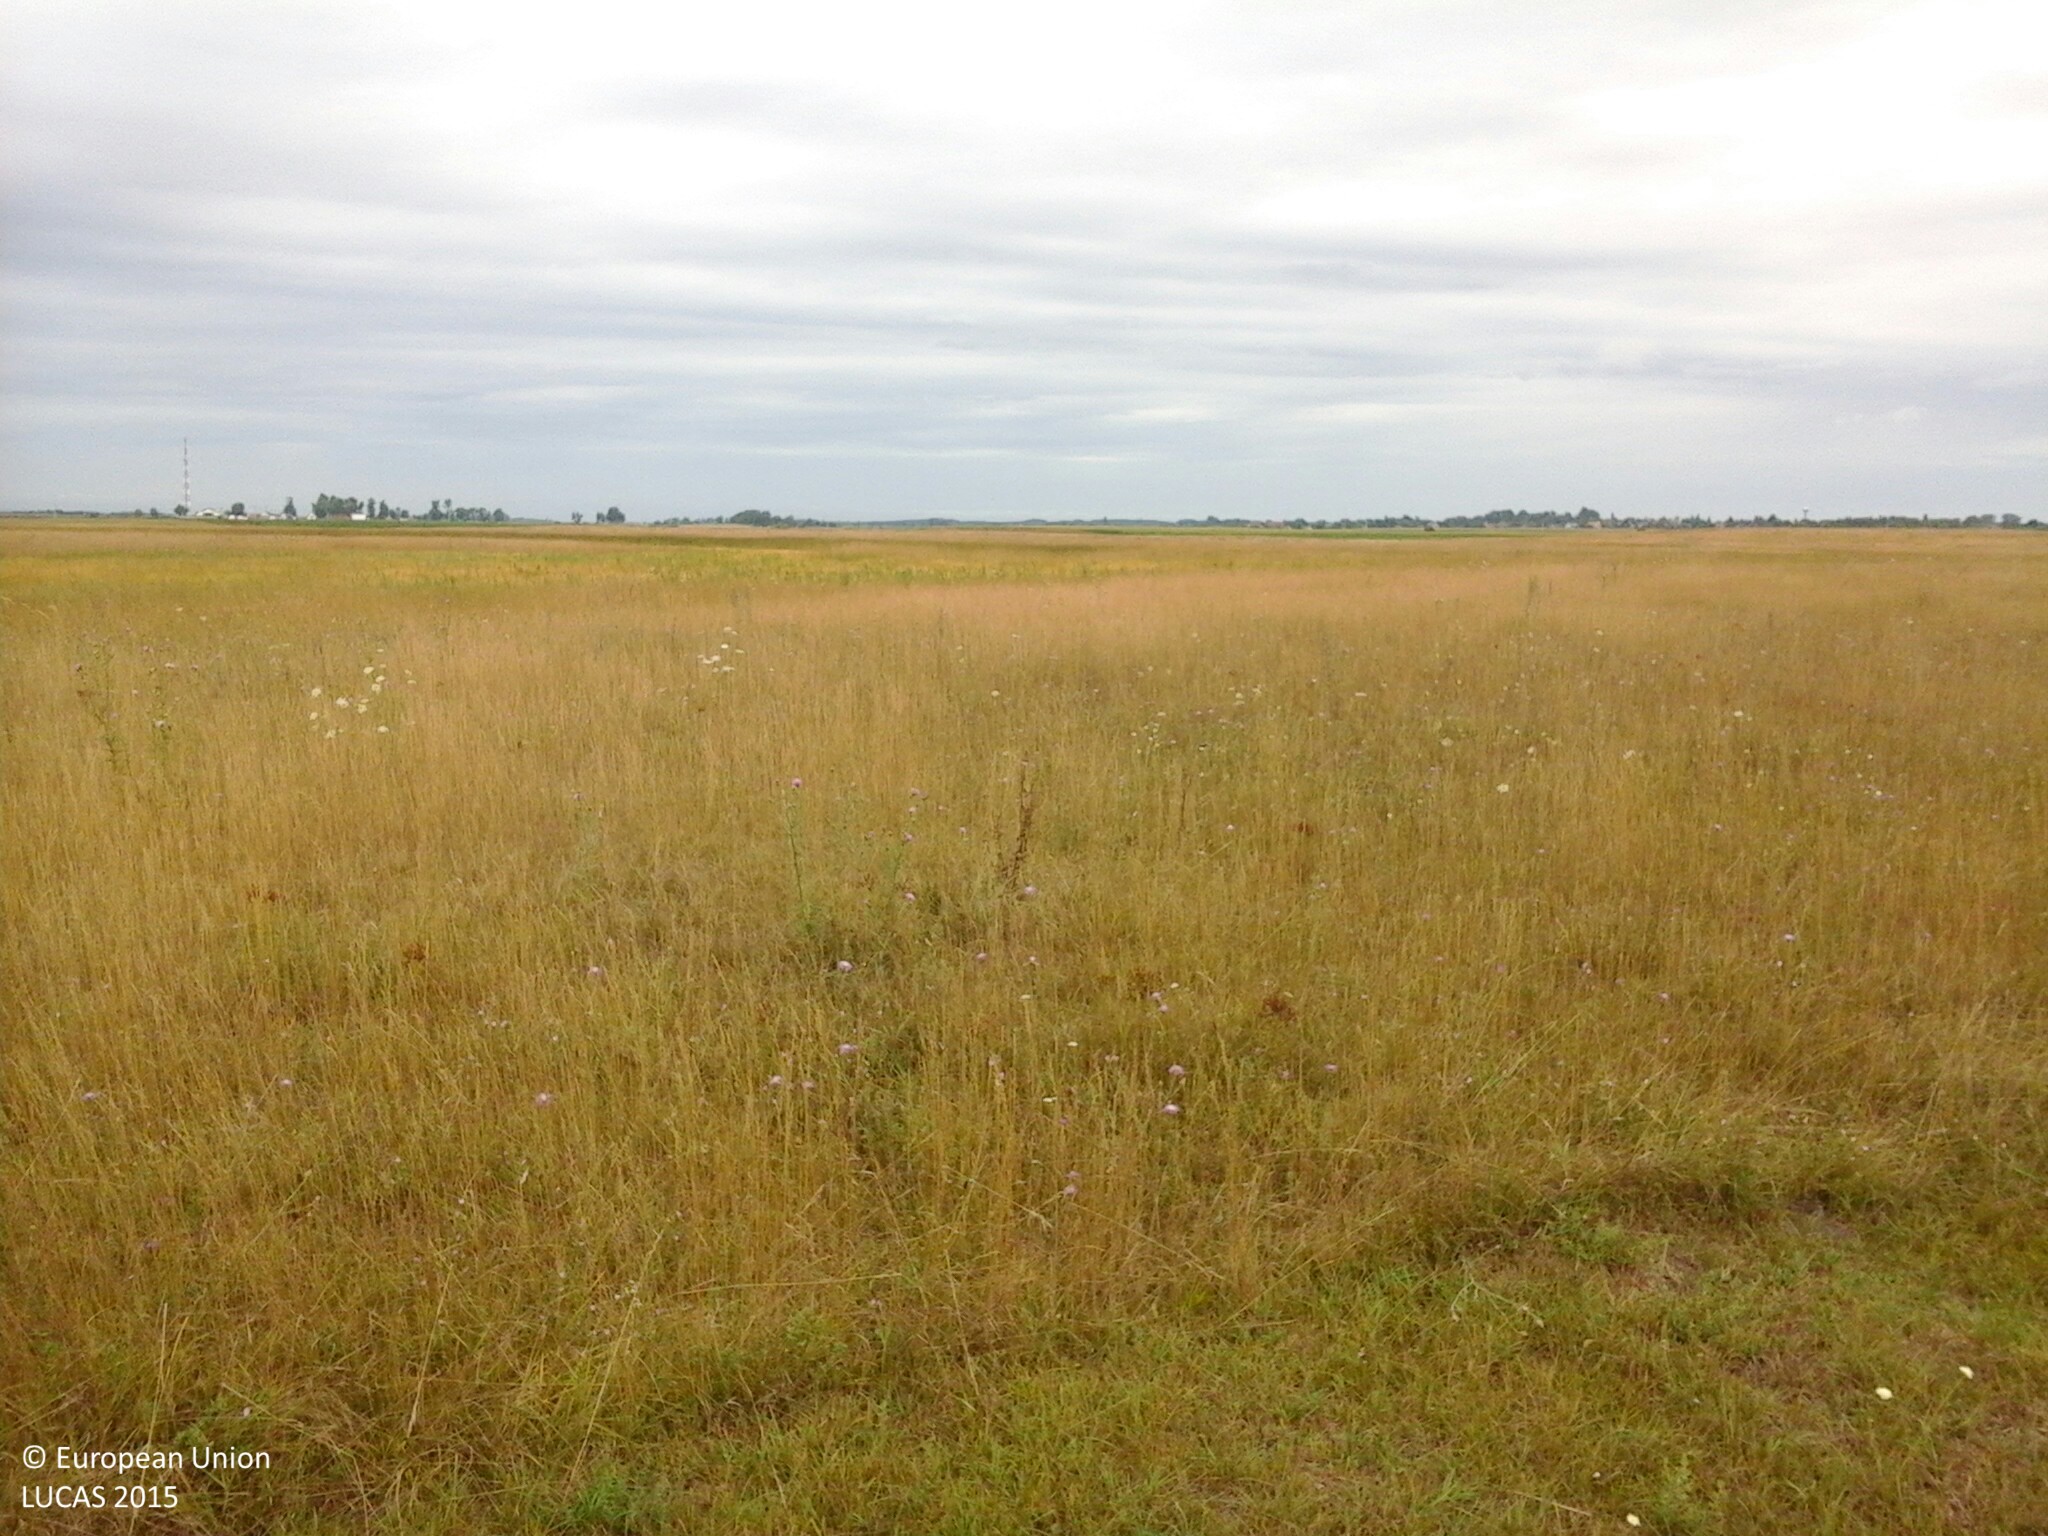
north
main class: Grassland
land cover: Grassland without tree/shrub cover
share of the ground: > 75 %
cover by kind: herbaceous plants 100 %
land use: Agriculture (excluding fallow land and kitchen gardens)
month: July
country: HU
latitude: 47.0063
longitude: 18.5221
